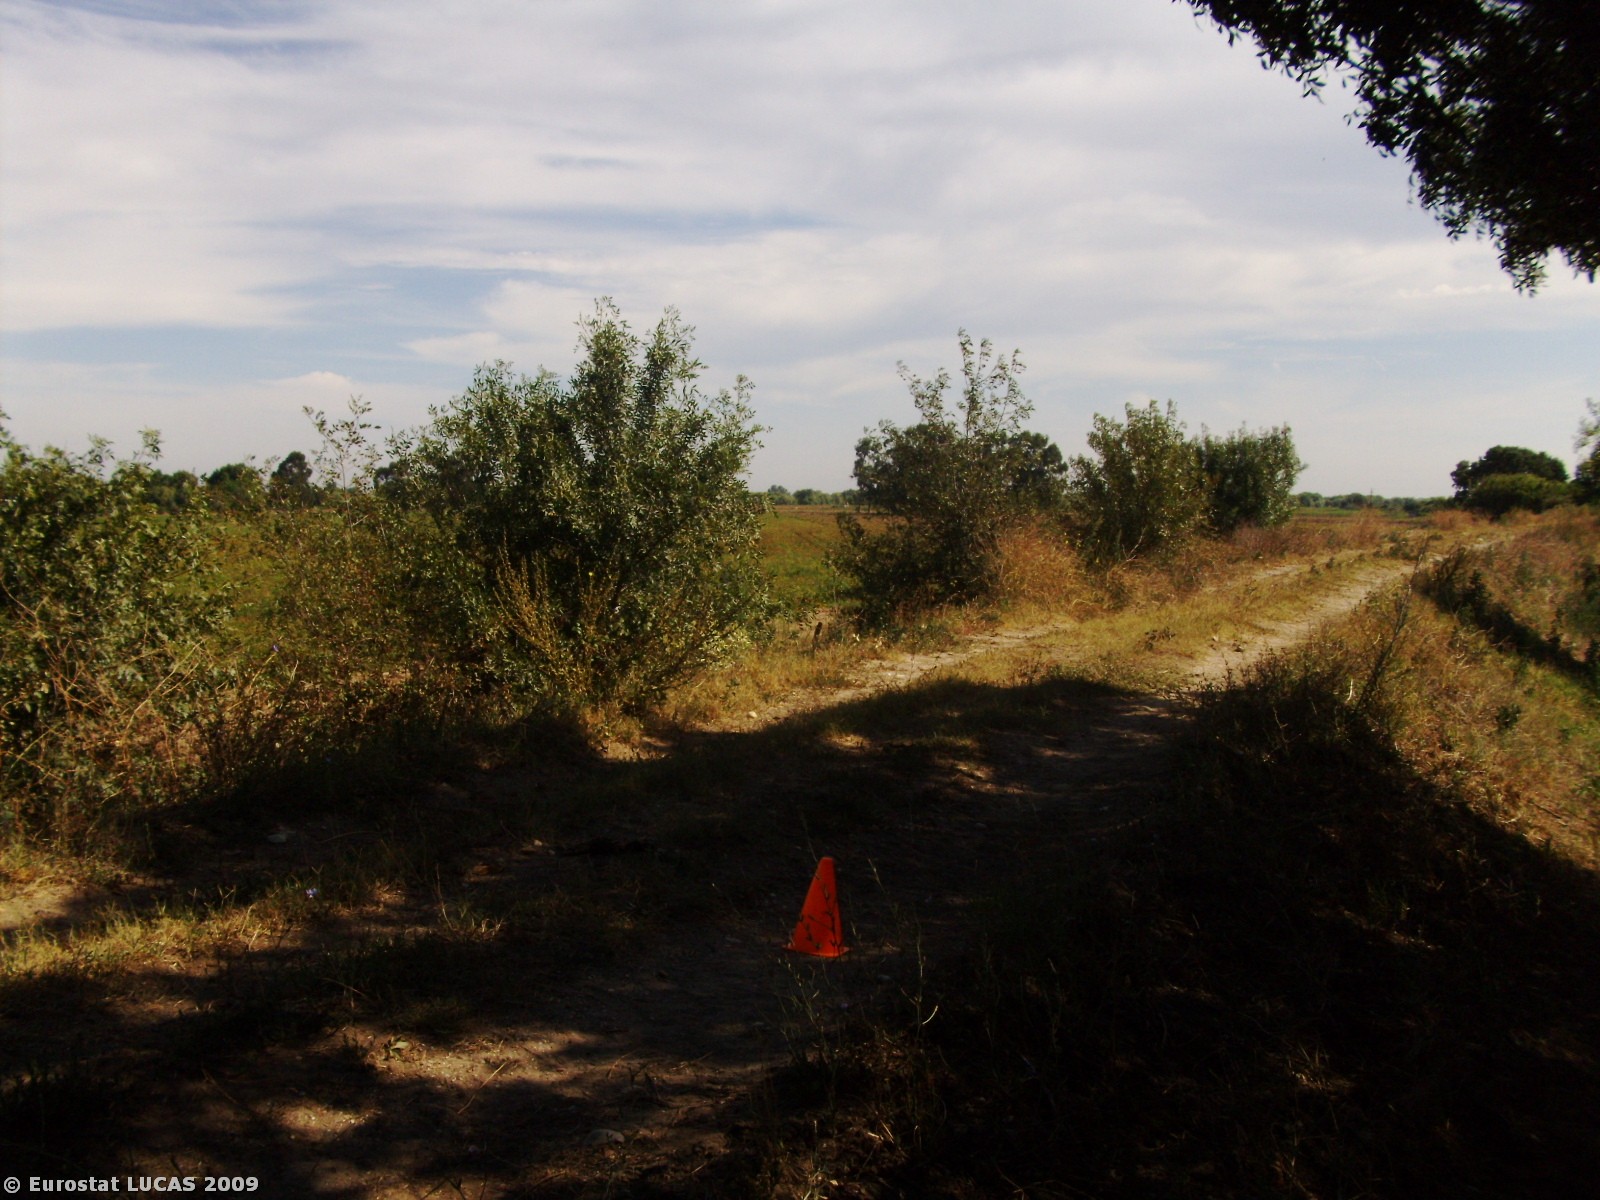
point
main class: Grassland
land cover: Grassland with sparse tree/shrub cover
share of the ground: 50 - 75 %
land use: Agriculture (excluding fallow land and kitchen gardens)
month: August
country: PT
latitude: 39.0423
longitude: -8.8004
